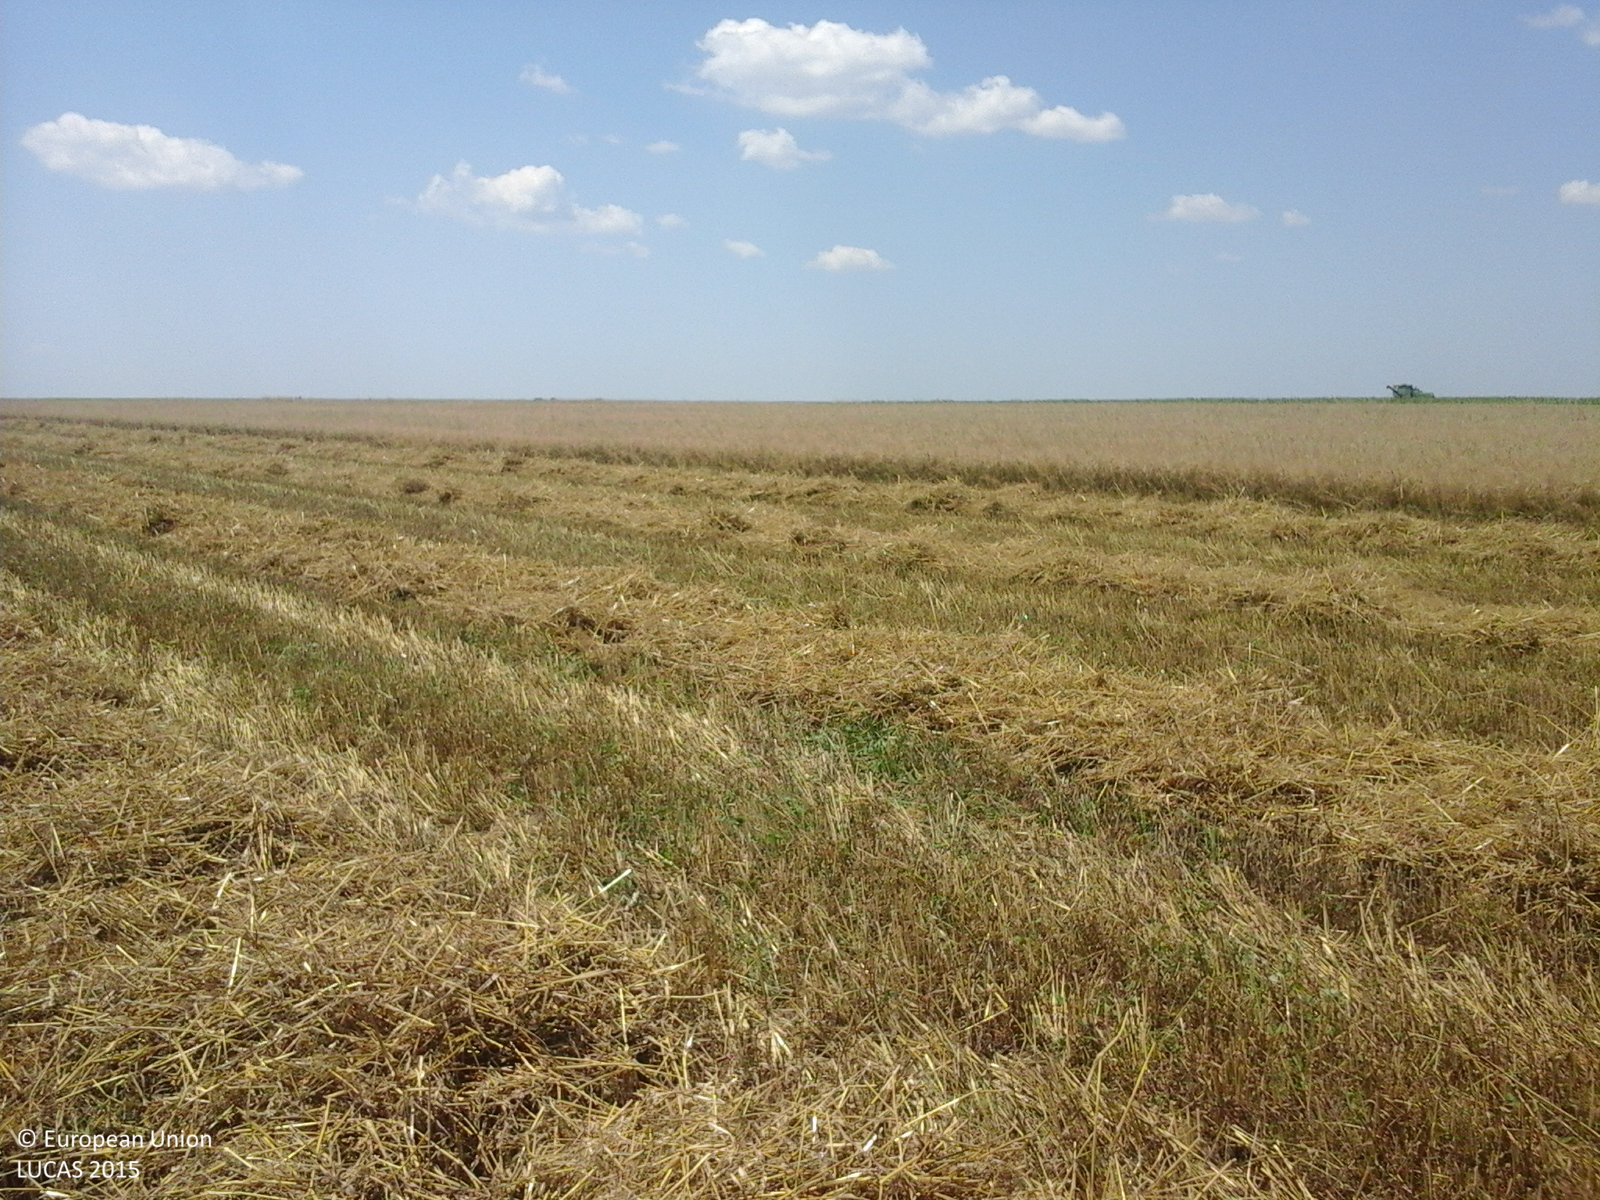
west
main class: Cropland
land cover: Common wheat
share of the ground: < 10 %
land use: Agriculture (excluding fallow land and kitchen gardens)
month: July
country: RO
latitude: 44.1872
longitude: 24.7476
